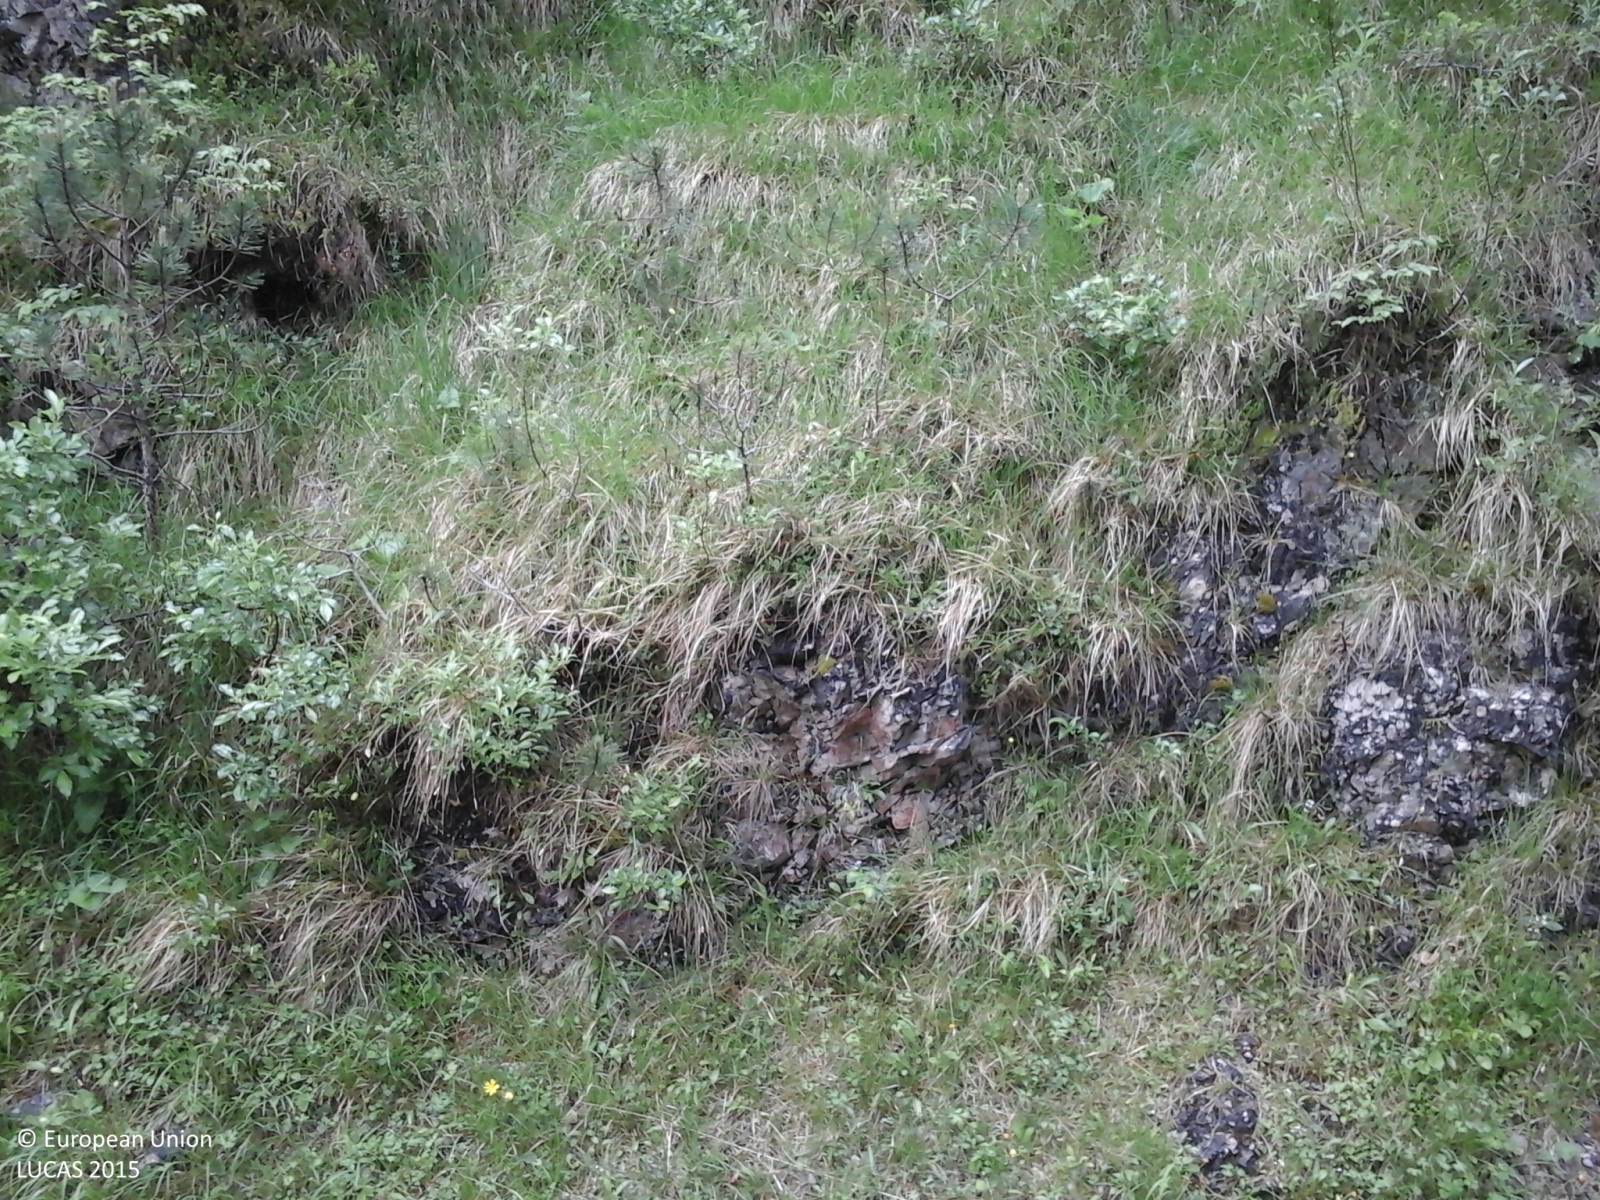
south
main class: Woodland
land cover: Other mixed woodland
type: mesophytic deciduous forest
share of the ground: > 75 %
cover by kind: broadleaved forest trees 60 %, coniferous forest trees 30 %, shrubs 10 %
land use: Semi-natural and natural areas not in use
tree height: > 5 m
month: June
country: IT
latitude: 46.2180
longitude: 12.3176
